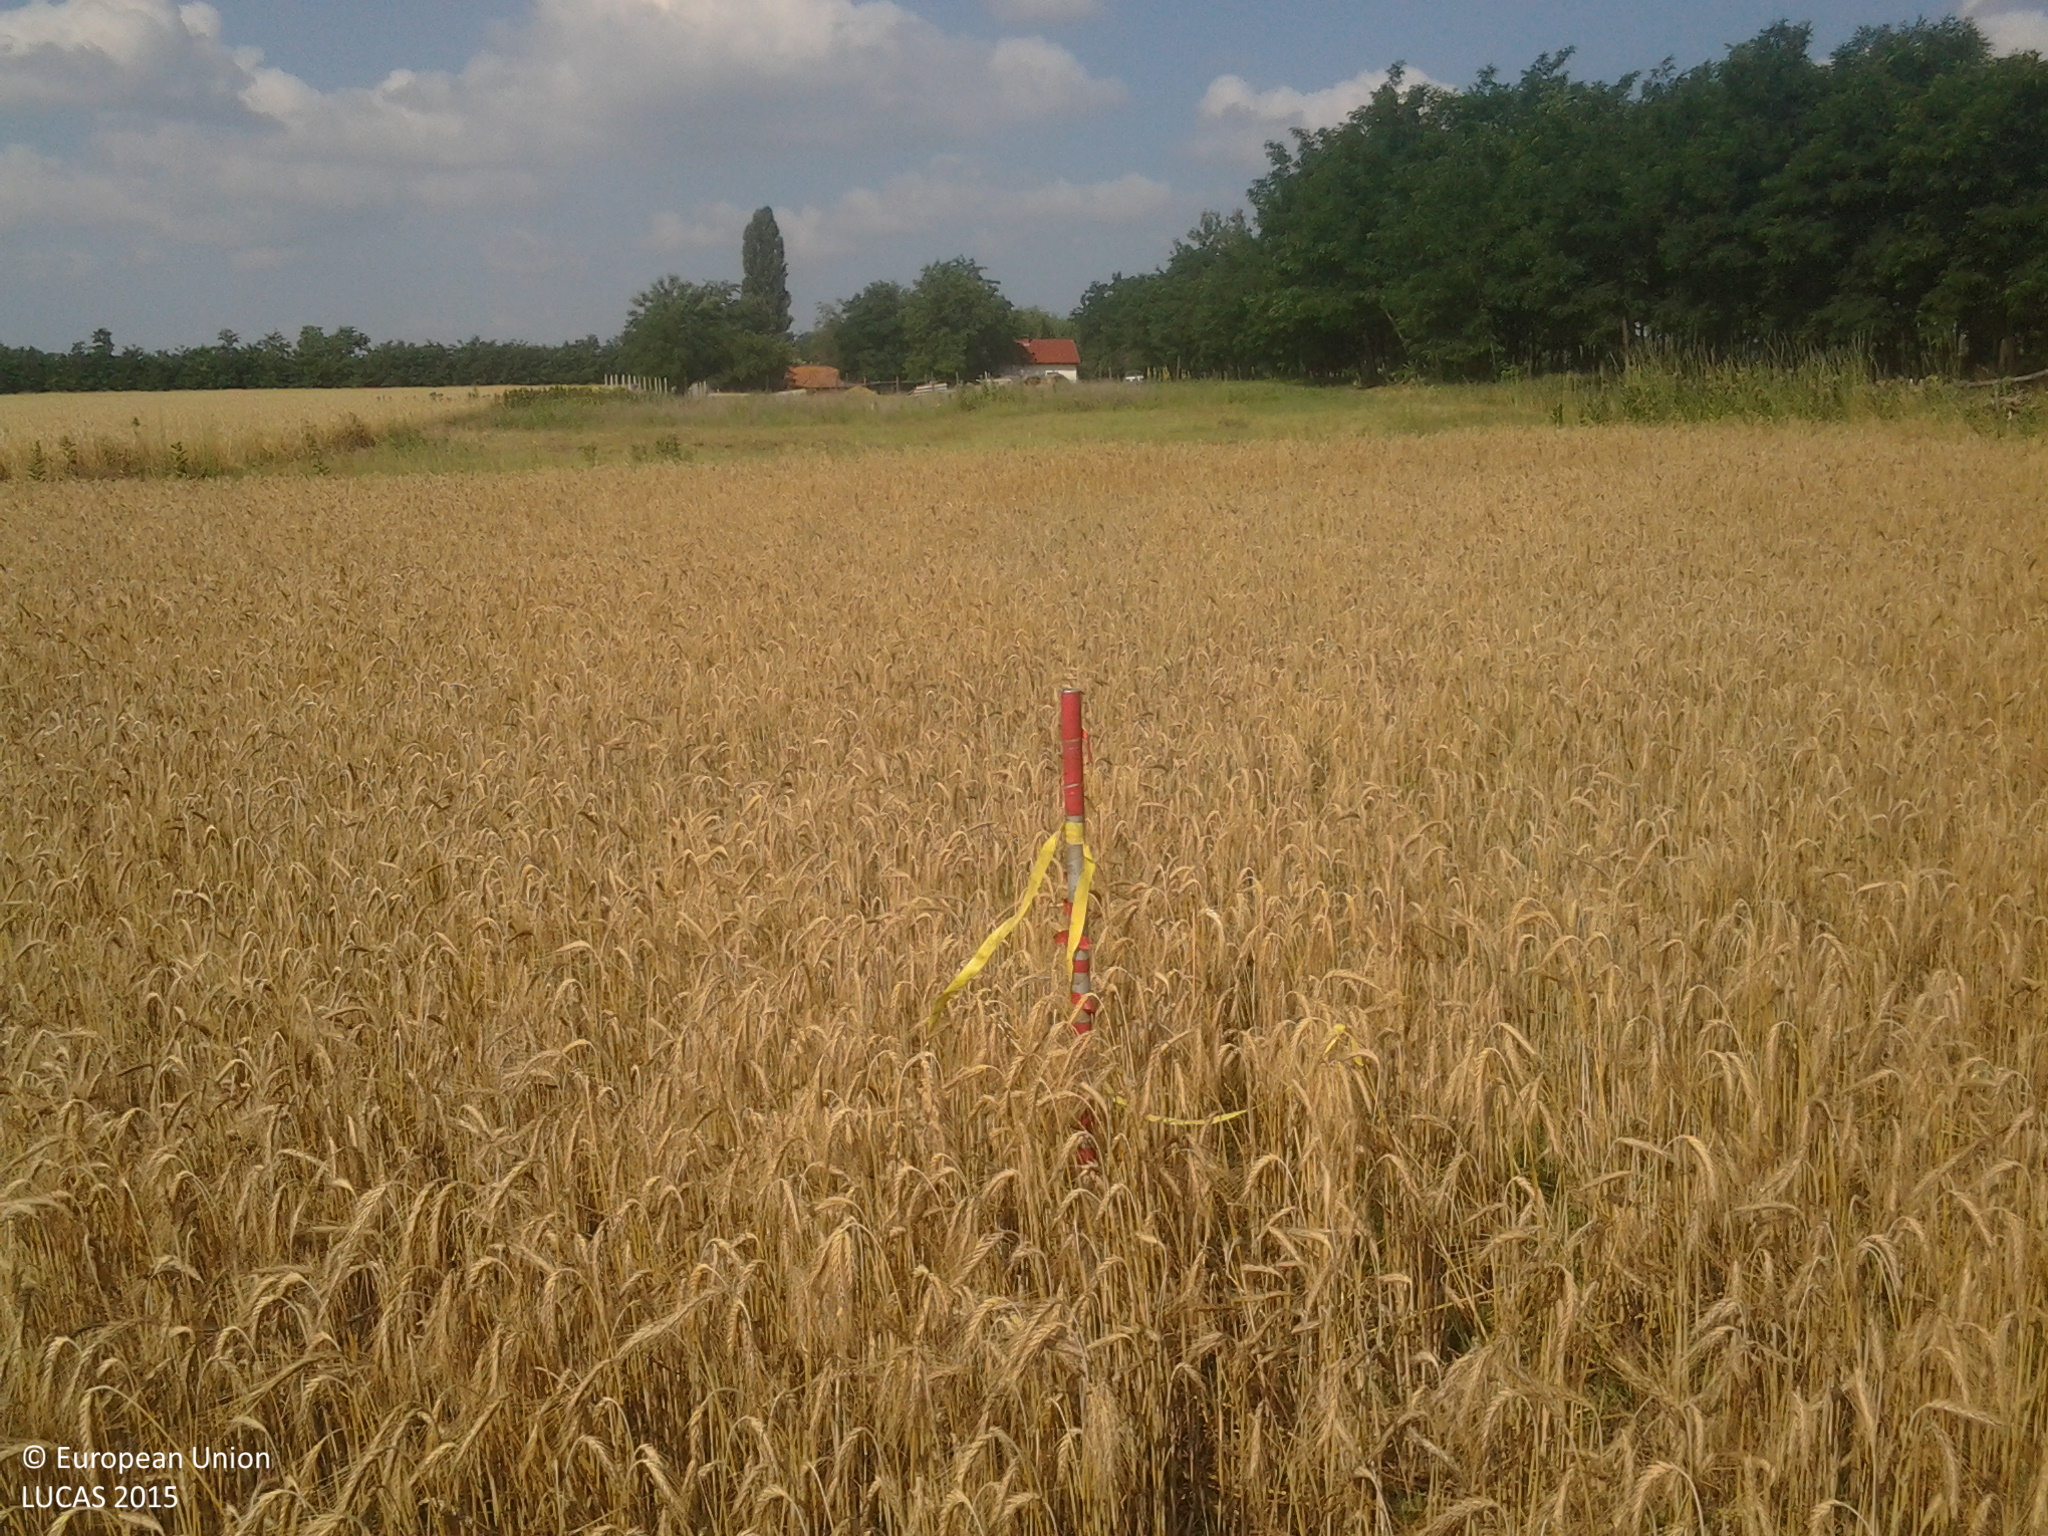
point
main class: Cropland
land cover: Barley
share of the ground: > 75 %
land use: Agriculture (excluding fallow land and kitchen gardens)
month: June
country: HU
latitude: 46.7216
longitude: 19.7414
